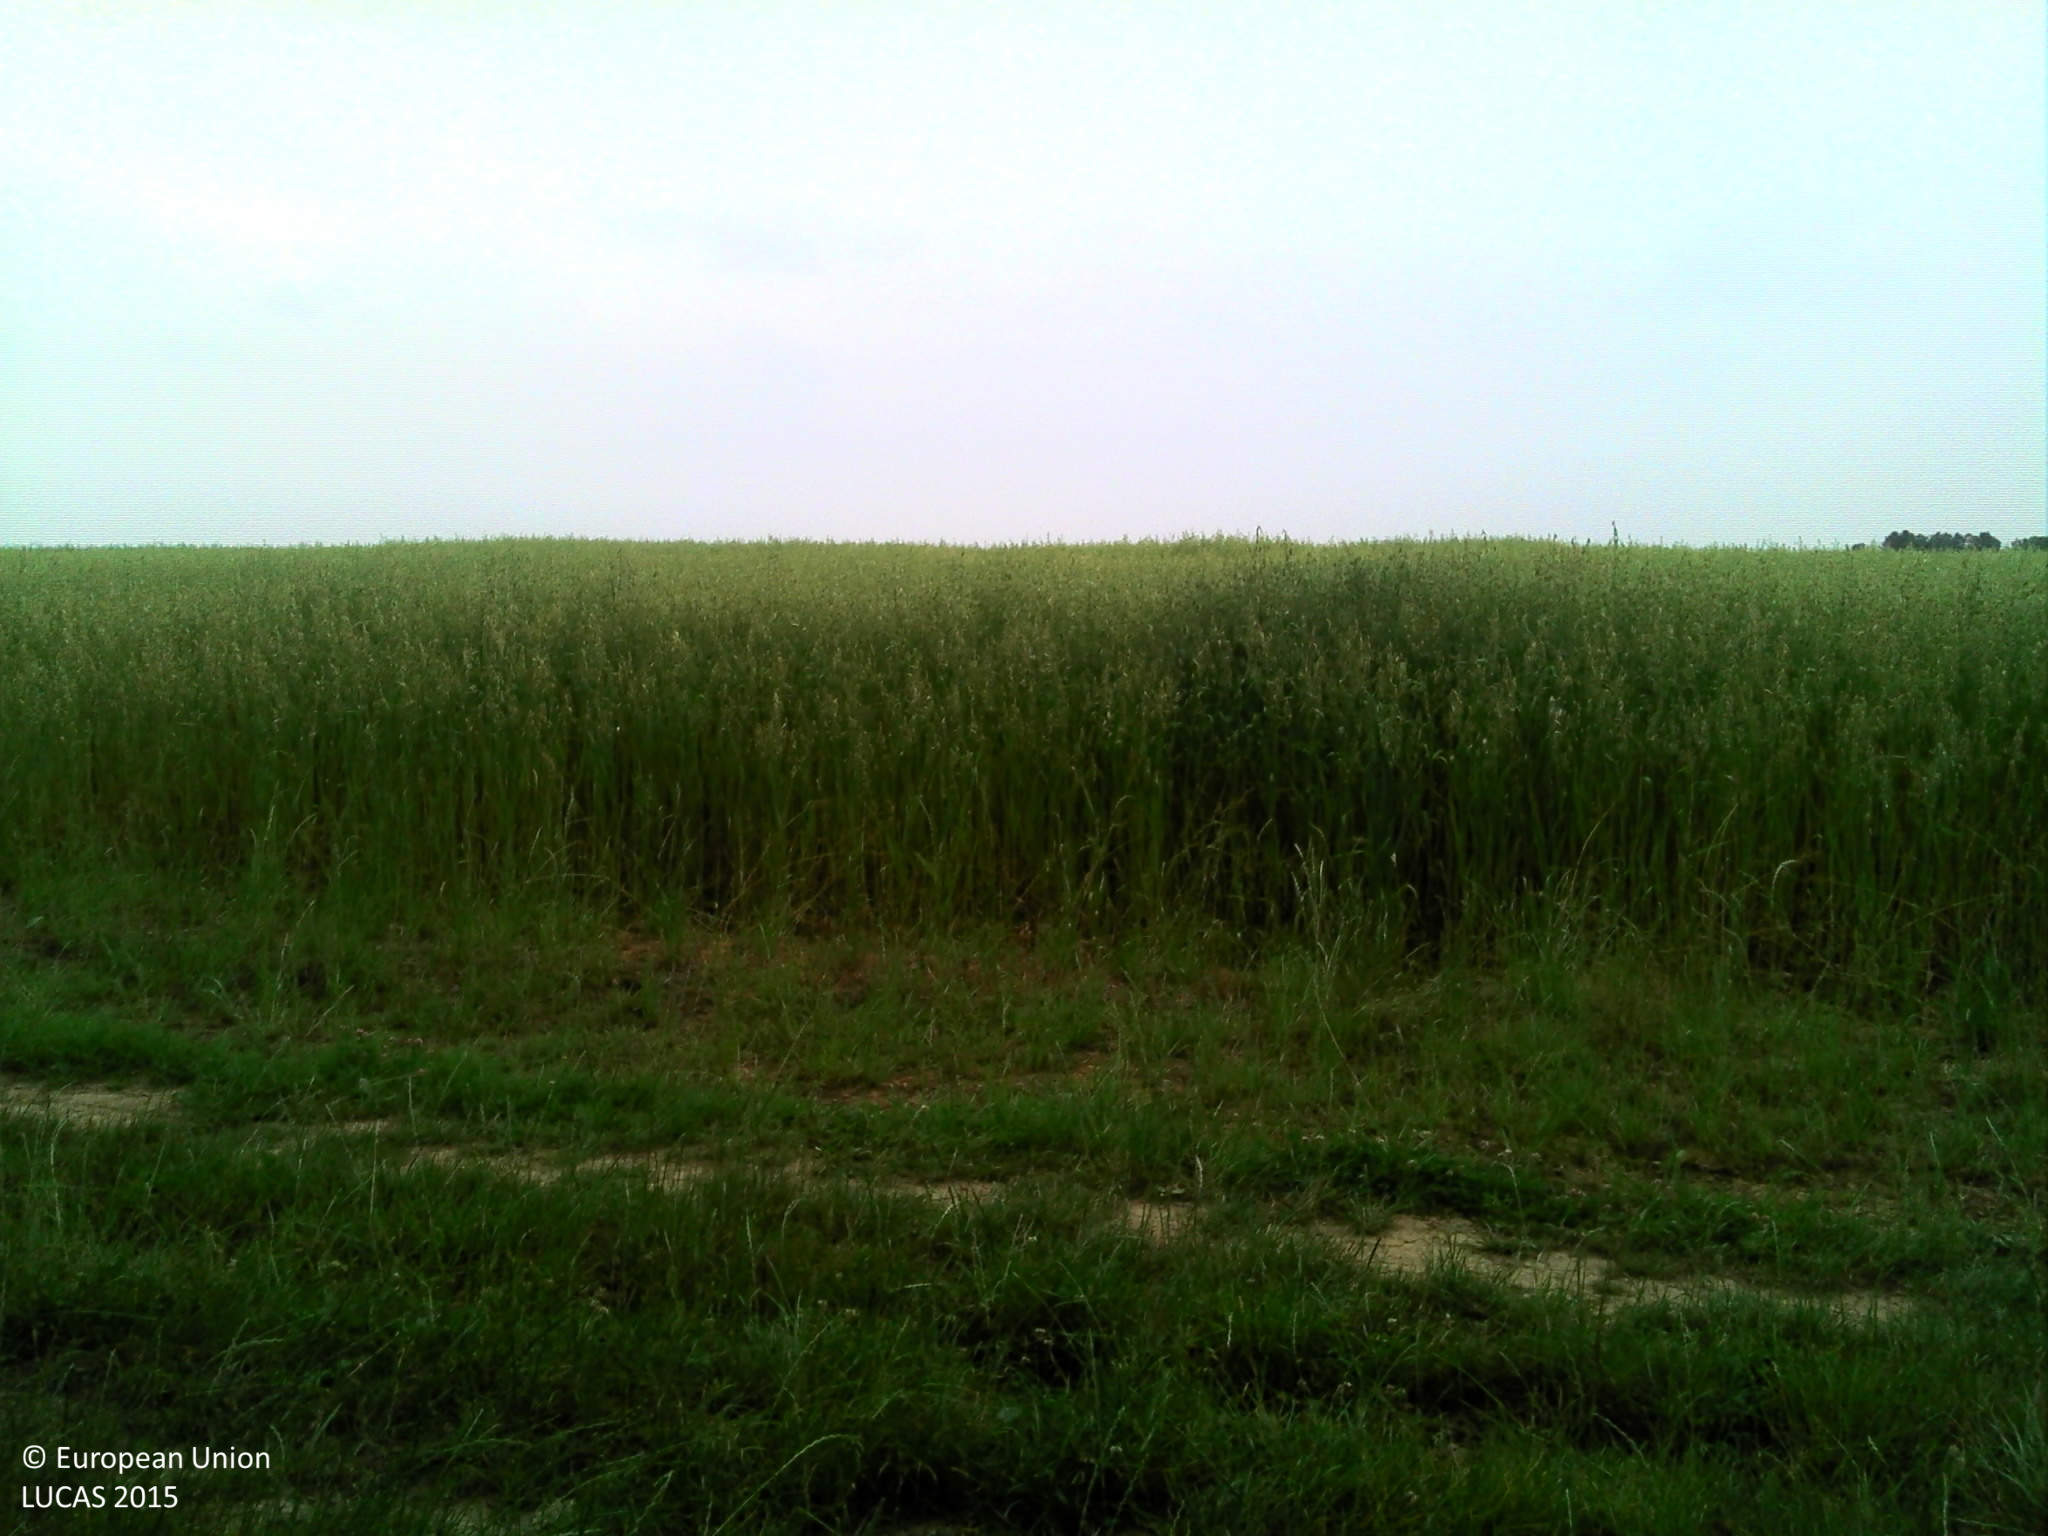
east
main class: Cropland
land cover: Oats
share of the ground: > 75 %
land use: Agriculture (excluding fallow land and kitchen gardens)
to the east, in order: Oats; Maize
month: June
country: FR
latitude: 47.9242
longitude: 3.8267
